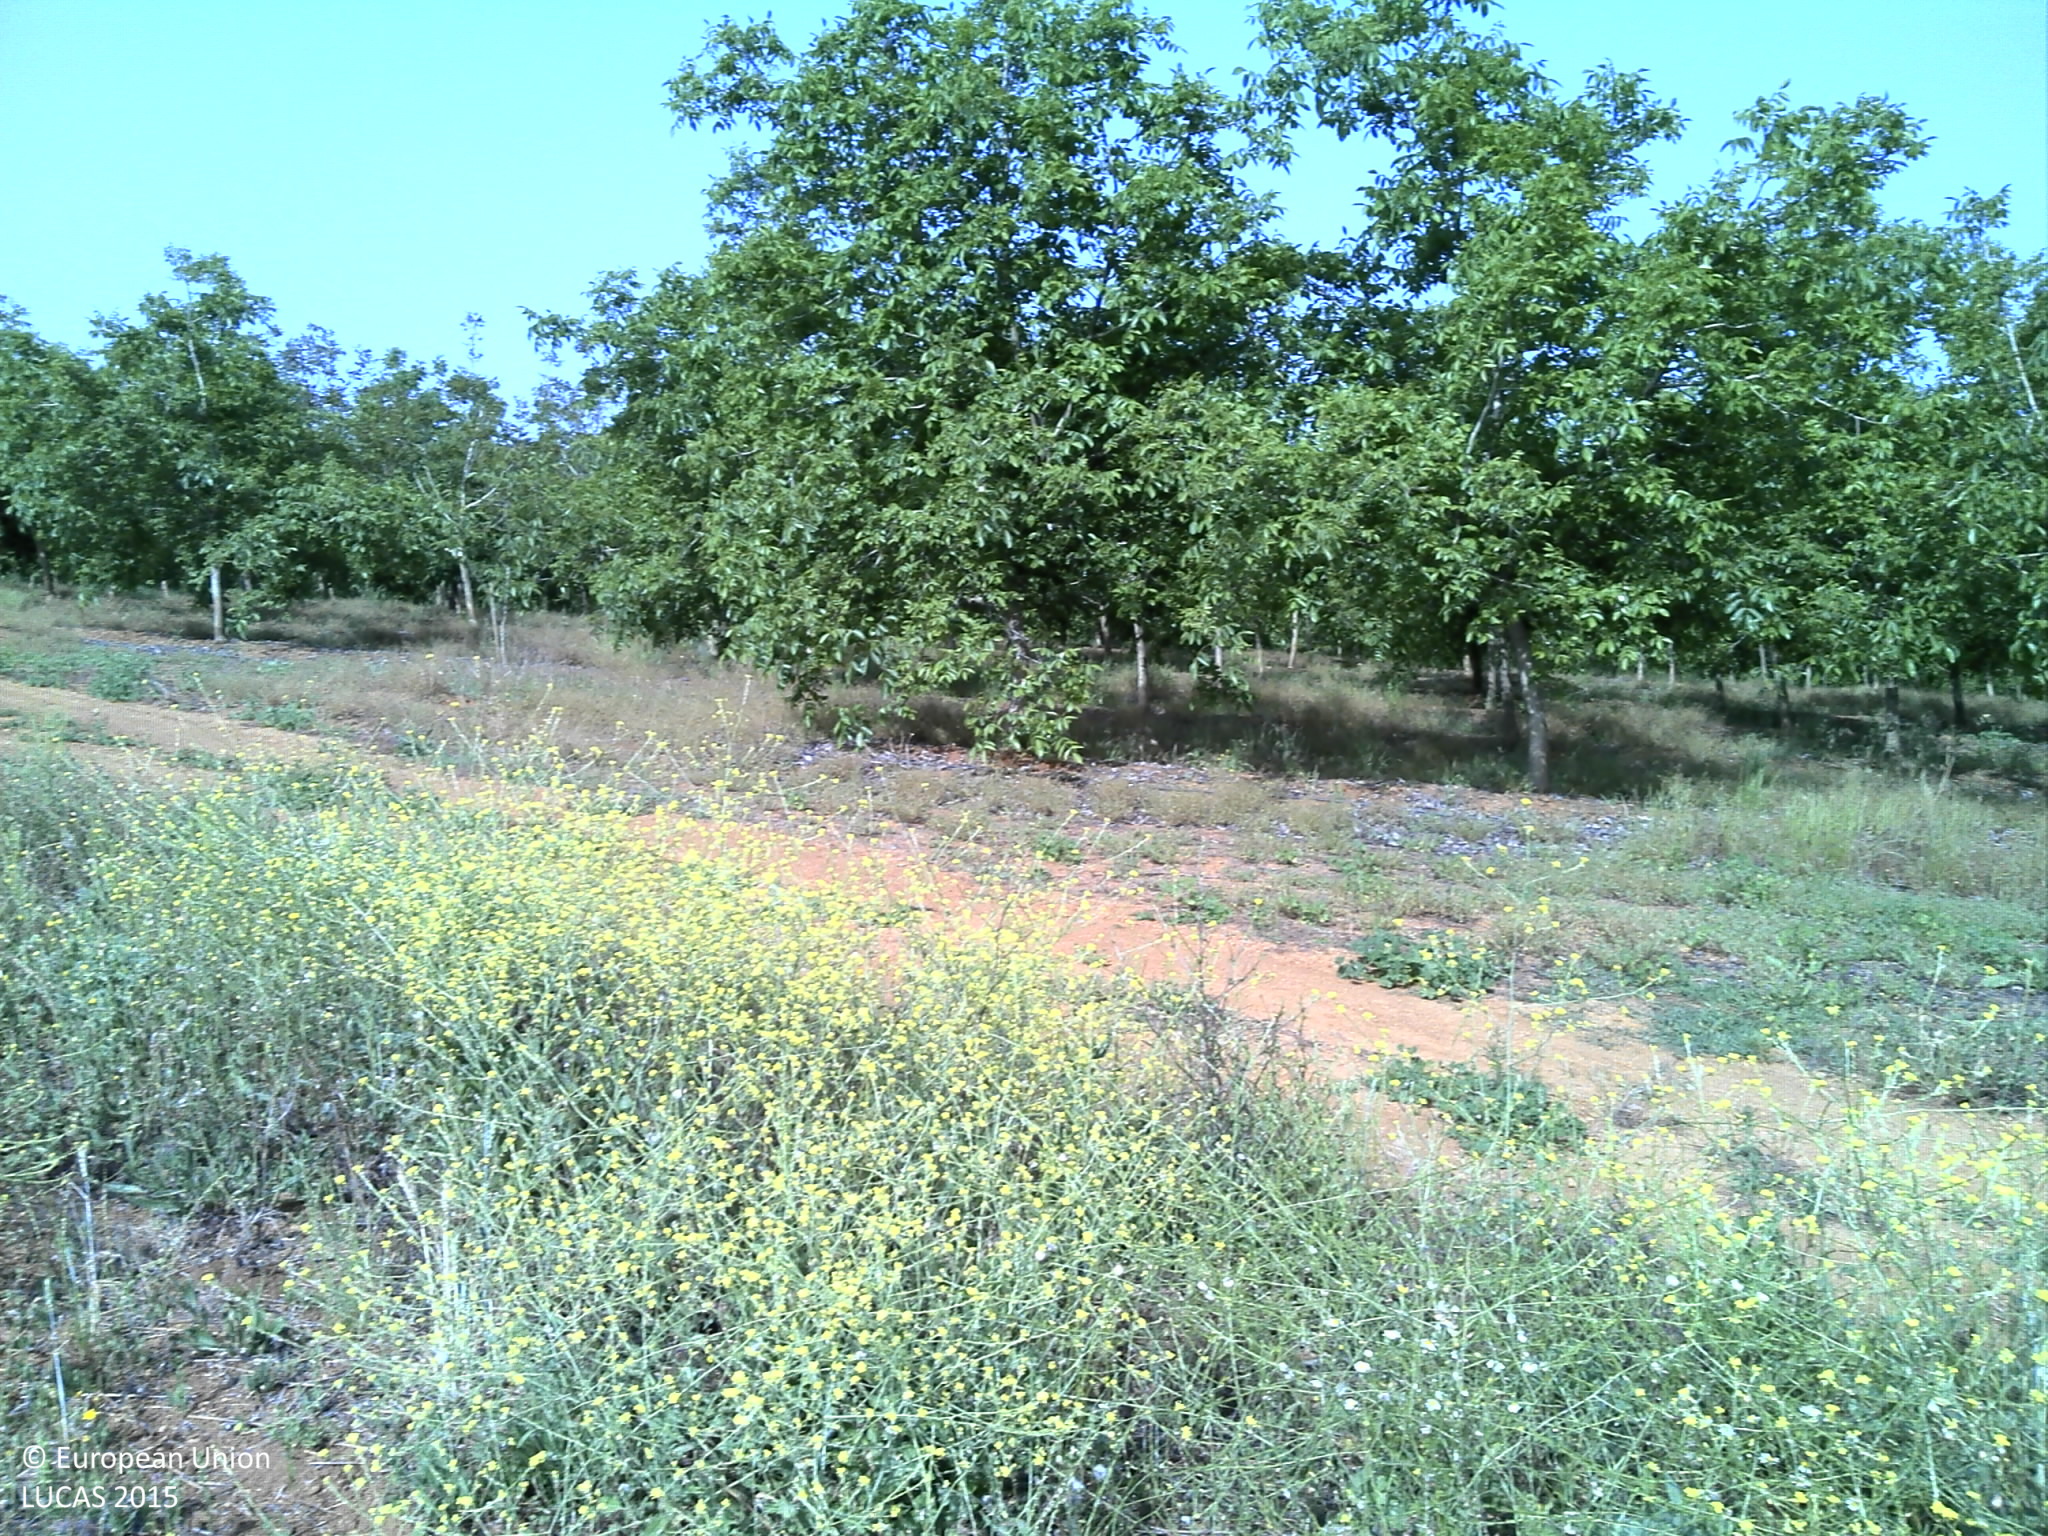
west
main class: Cropland
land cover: Mixed cereals for fodder
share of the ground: > 75 %
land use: Agriculture (excluding fallow land and kitchen gardens)
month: May
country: PT
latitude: 38.9784
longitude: -7.7861
